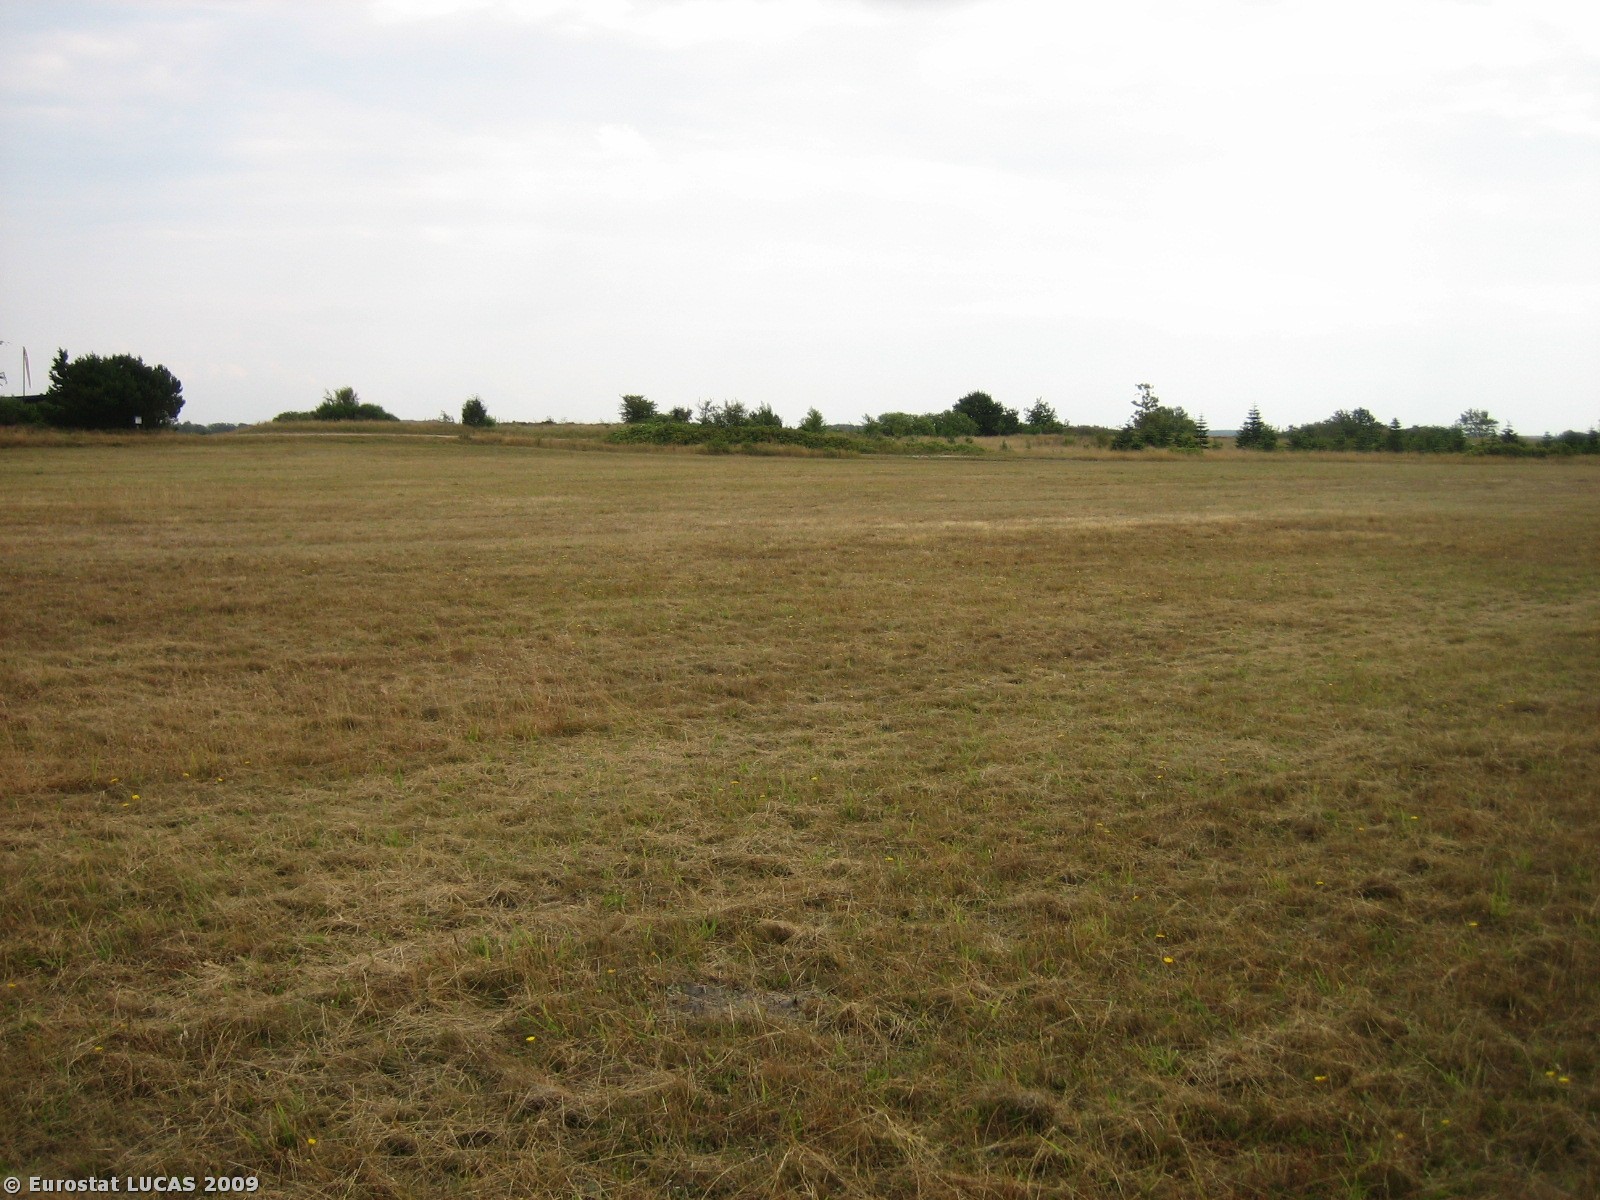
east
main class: Grassland
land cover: Grassland without tree/shrub cover
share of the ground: > 75 %
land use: Agriculture (excluding fallow land and kitchen gardens)
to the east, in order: Grassland without tree/shrub cover; Grass margins; Tracks; Grassland with sparse tree/shrub cover; Shrubland with sparse tree cover; Shrubland without tree cover
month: July
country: DK
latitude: 55.8724
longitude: 8.4194
